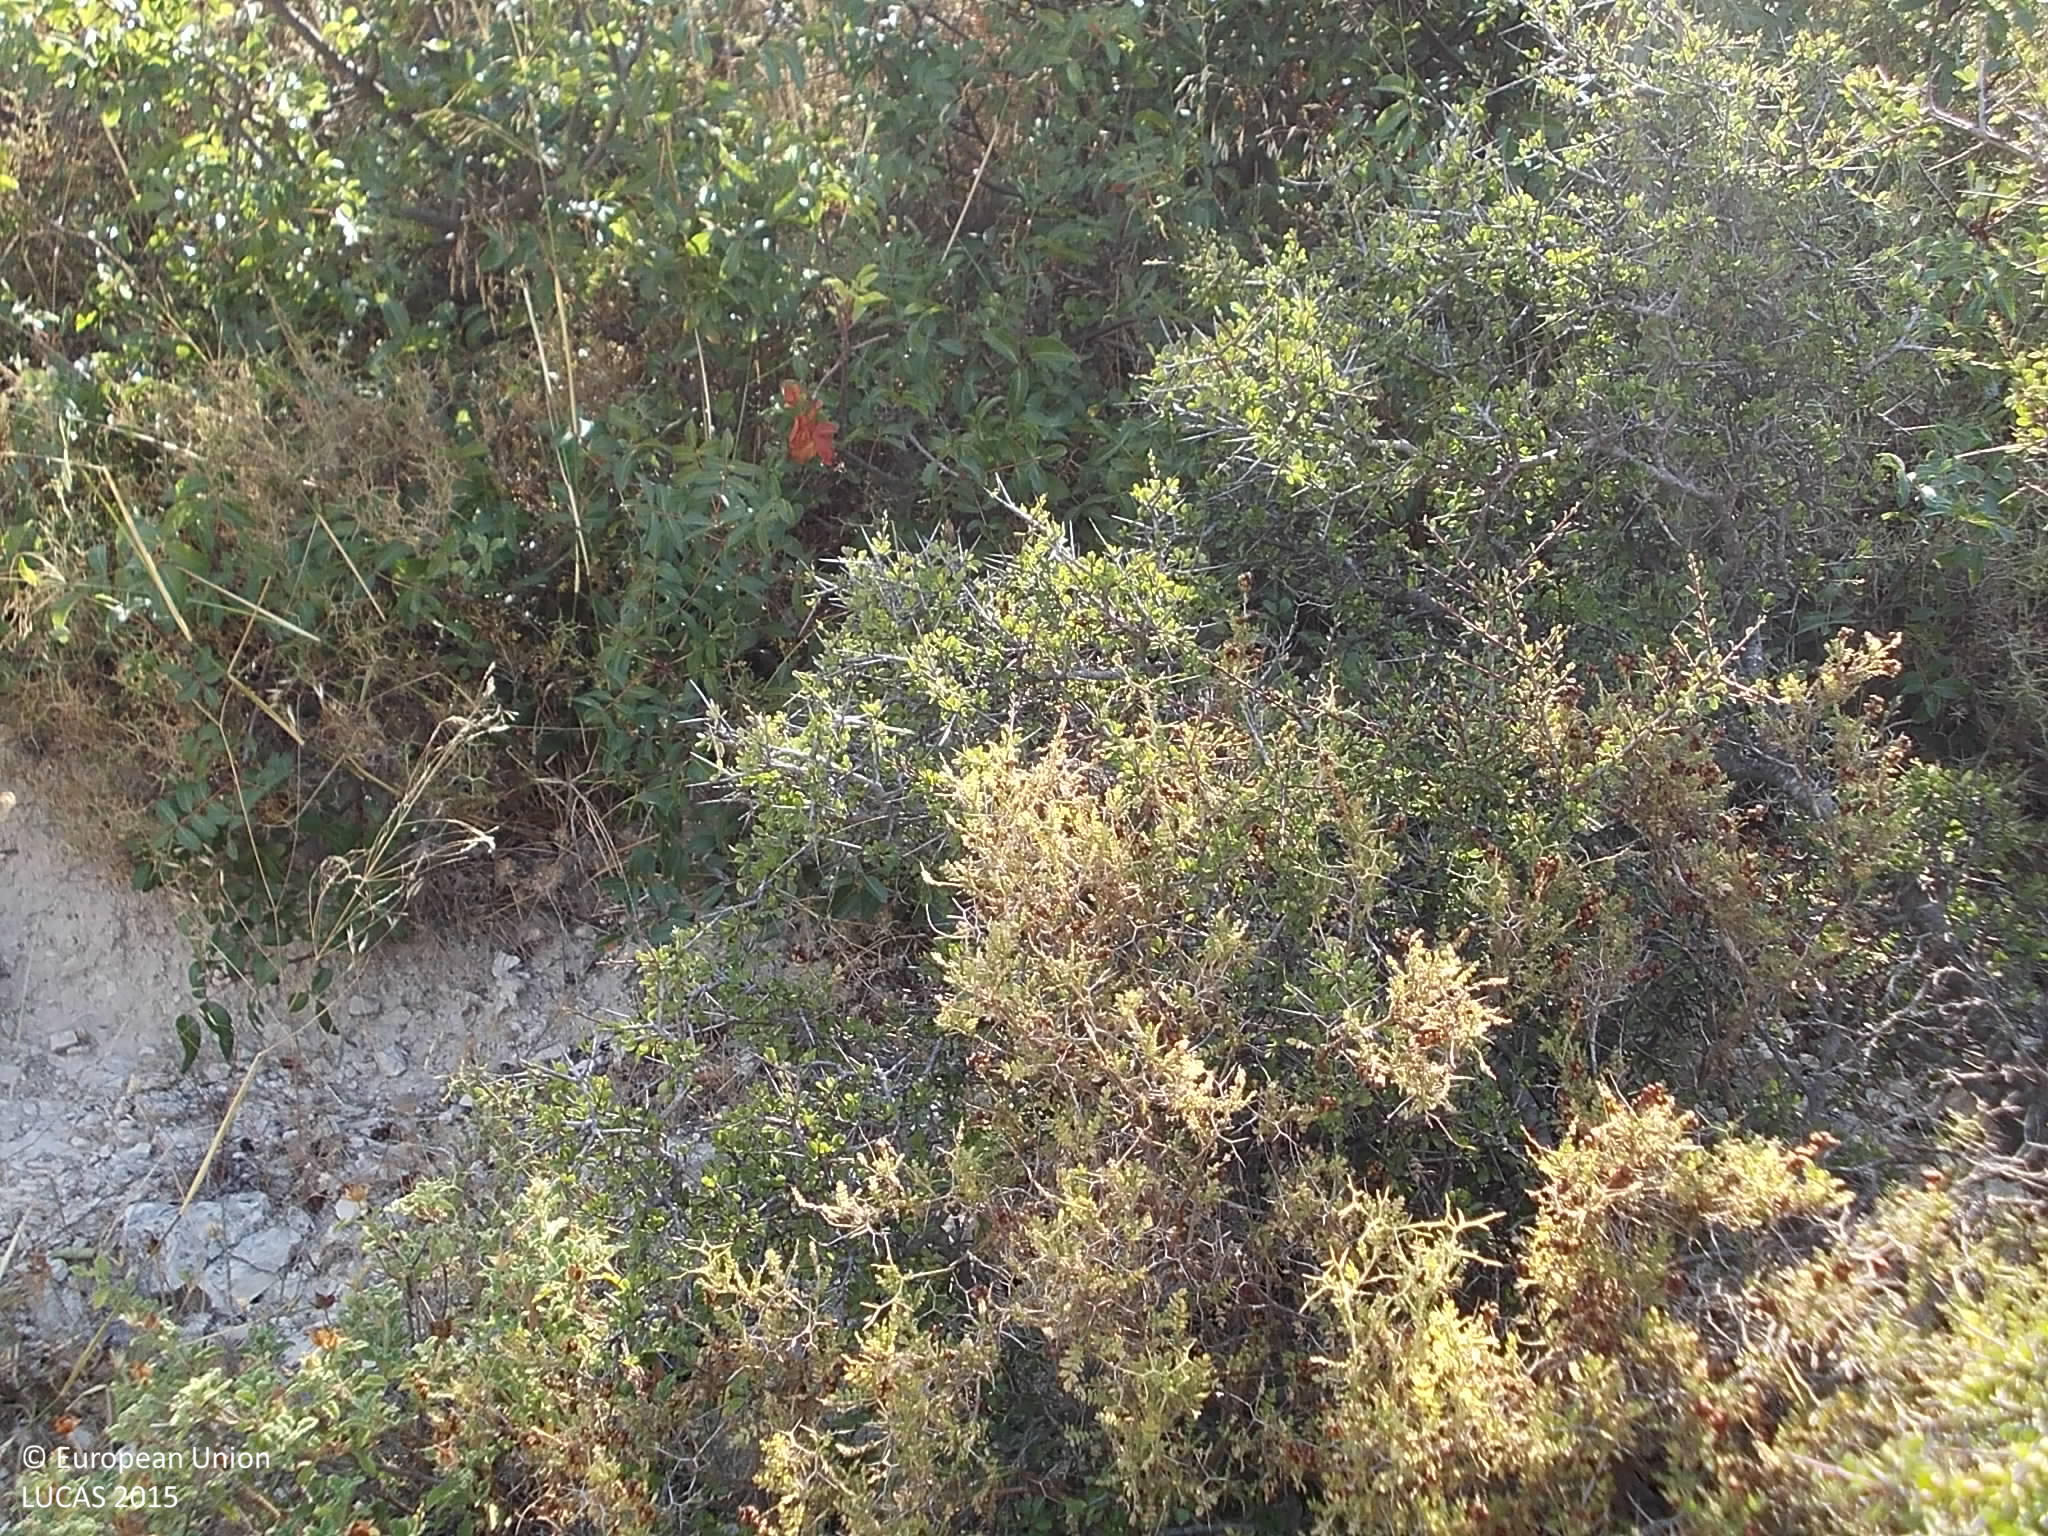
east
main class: Shrubland
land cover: Shrubland without tree cover
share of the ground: 50 - 75 %
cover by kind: shrubs 70 %, herbaceous plants 20 %, unconsolidated bare surface 10 %
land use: Semi-natural and natural areas not in use
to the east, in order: Shrubland without tree cover; Tracks; Broadleaved woodland
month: July
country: CY
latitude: 34.7891
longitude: 32.7242
